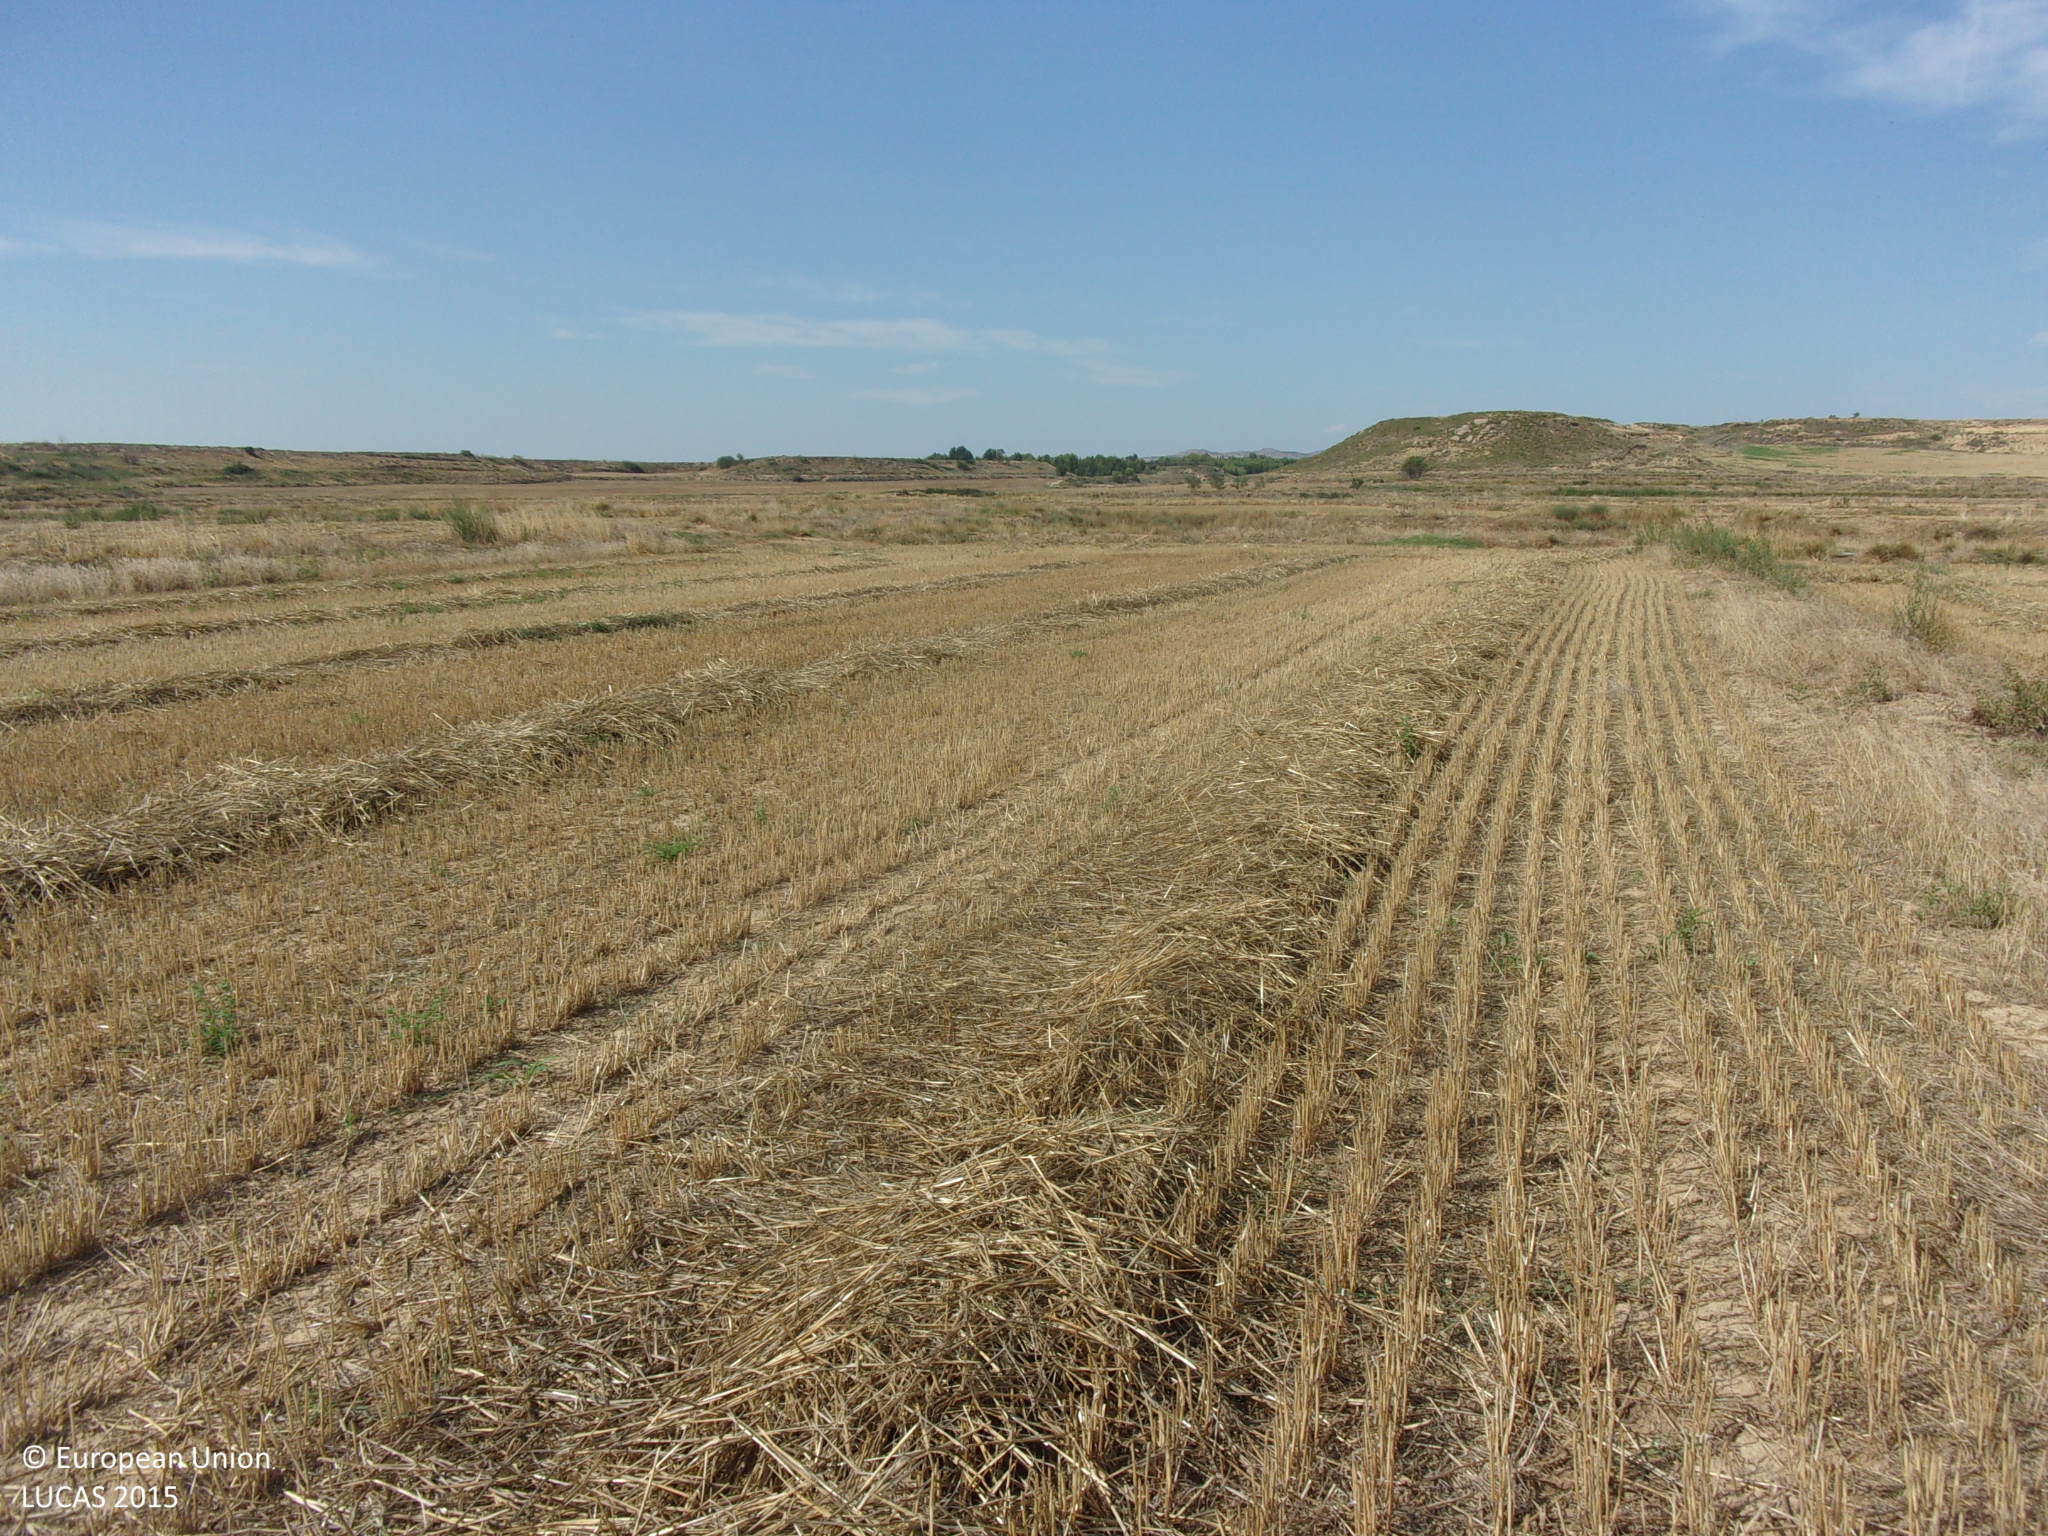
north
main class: Cropland
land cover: Common wheat
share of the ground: < 10 %
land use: Agriculture (excluding fallow land and kitchen gardens)
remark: Harvested field
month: August
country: ES
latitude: 42.1994
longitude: -1.1587
